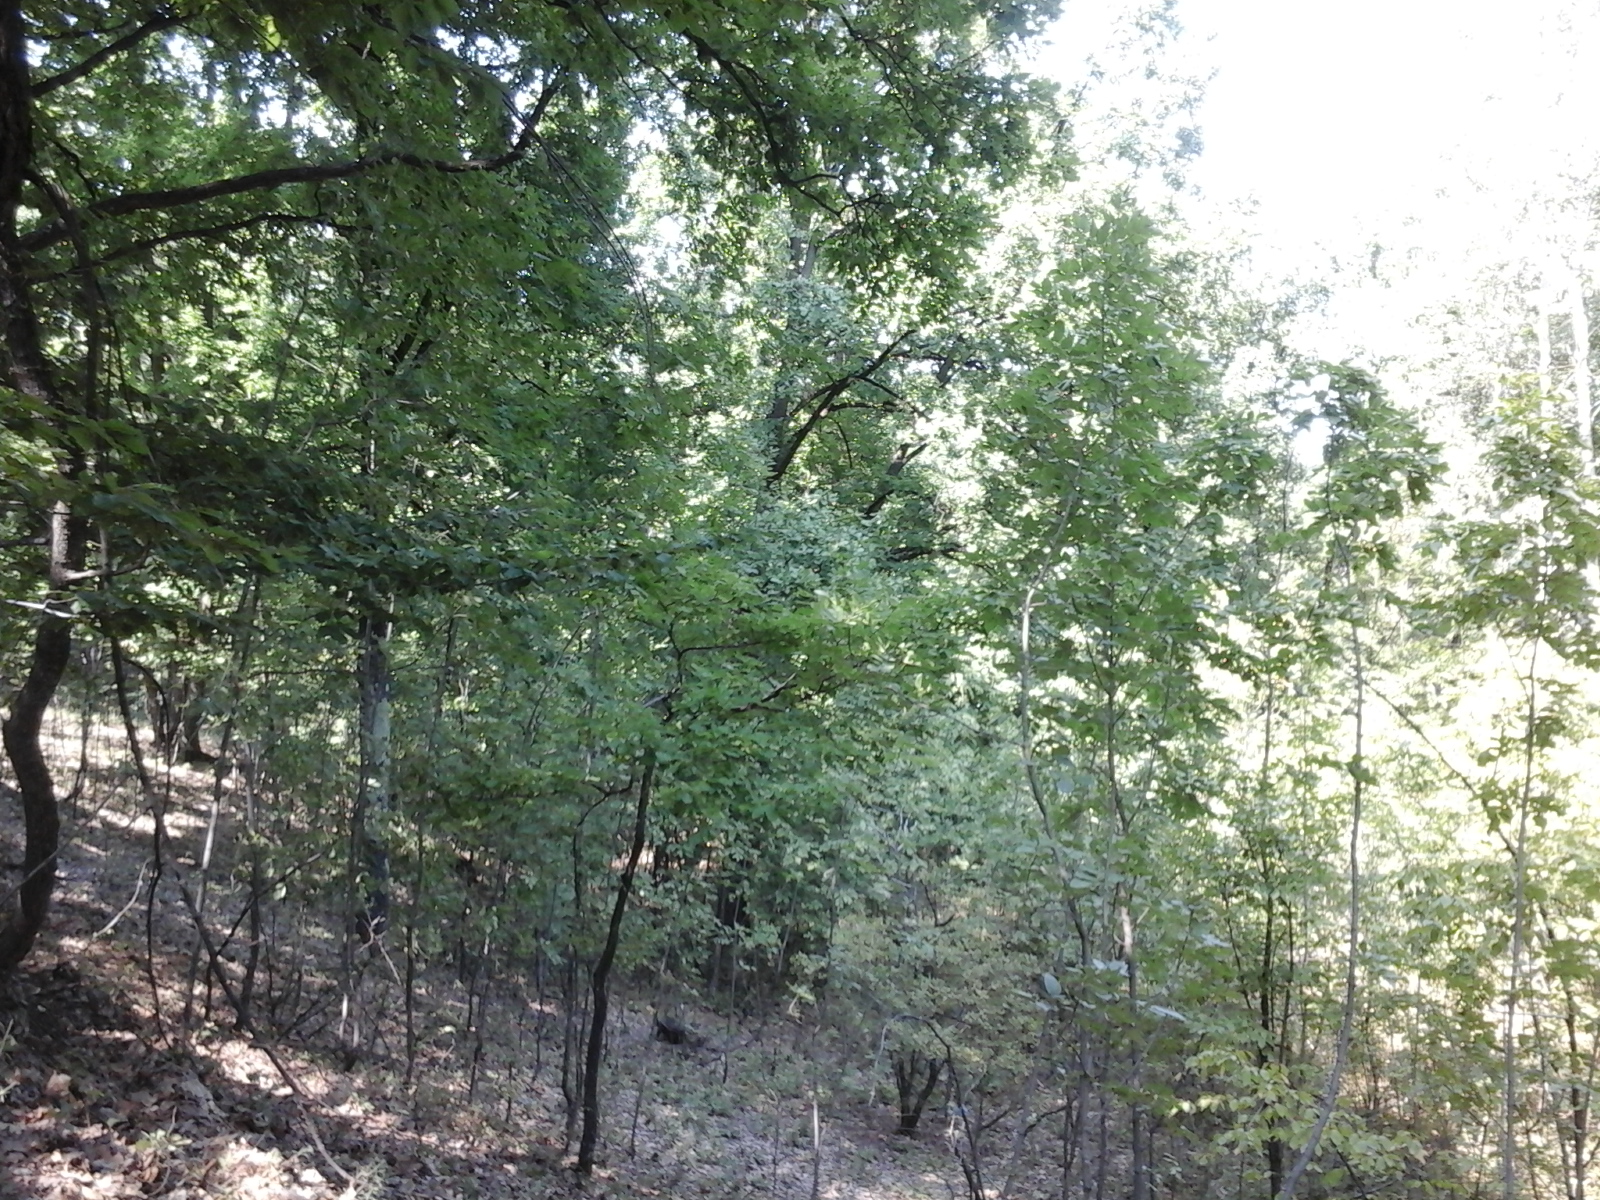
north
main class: Woodland
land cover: Broadleaved woodland
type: acidophilous oak and oak-birch forest
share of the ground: > 75 %
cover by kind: broadleaved forest trees 100 %
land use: Forestry
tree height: > 5 m
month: August
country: RO
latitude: 44.8755
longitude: 23.8731
